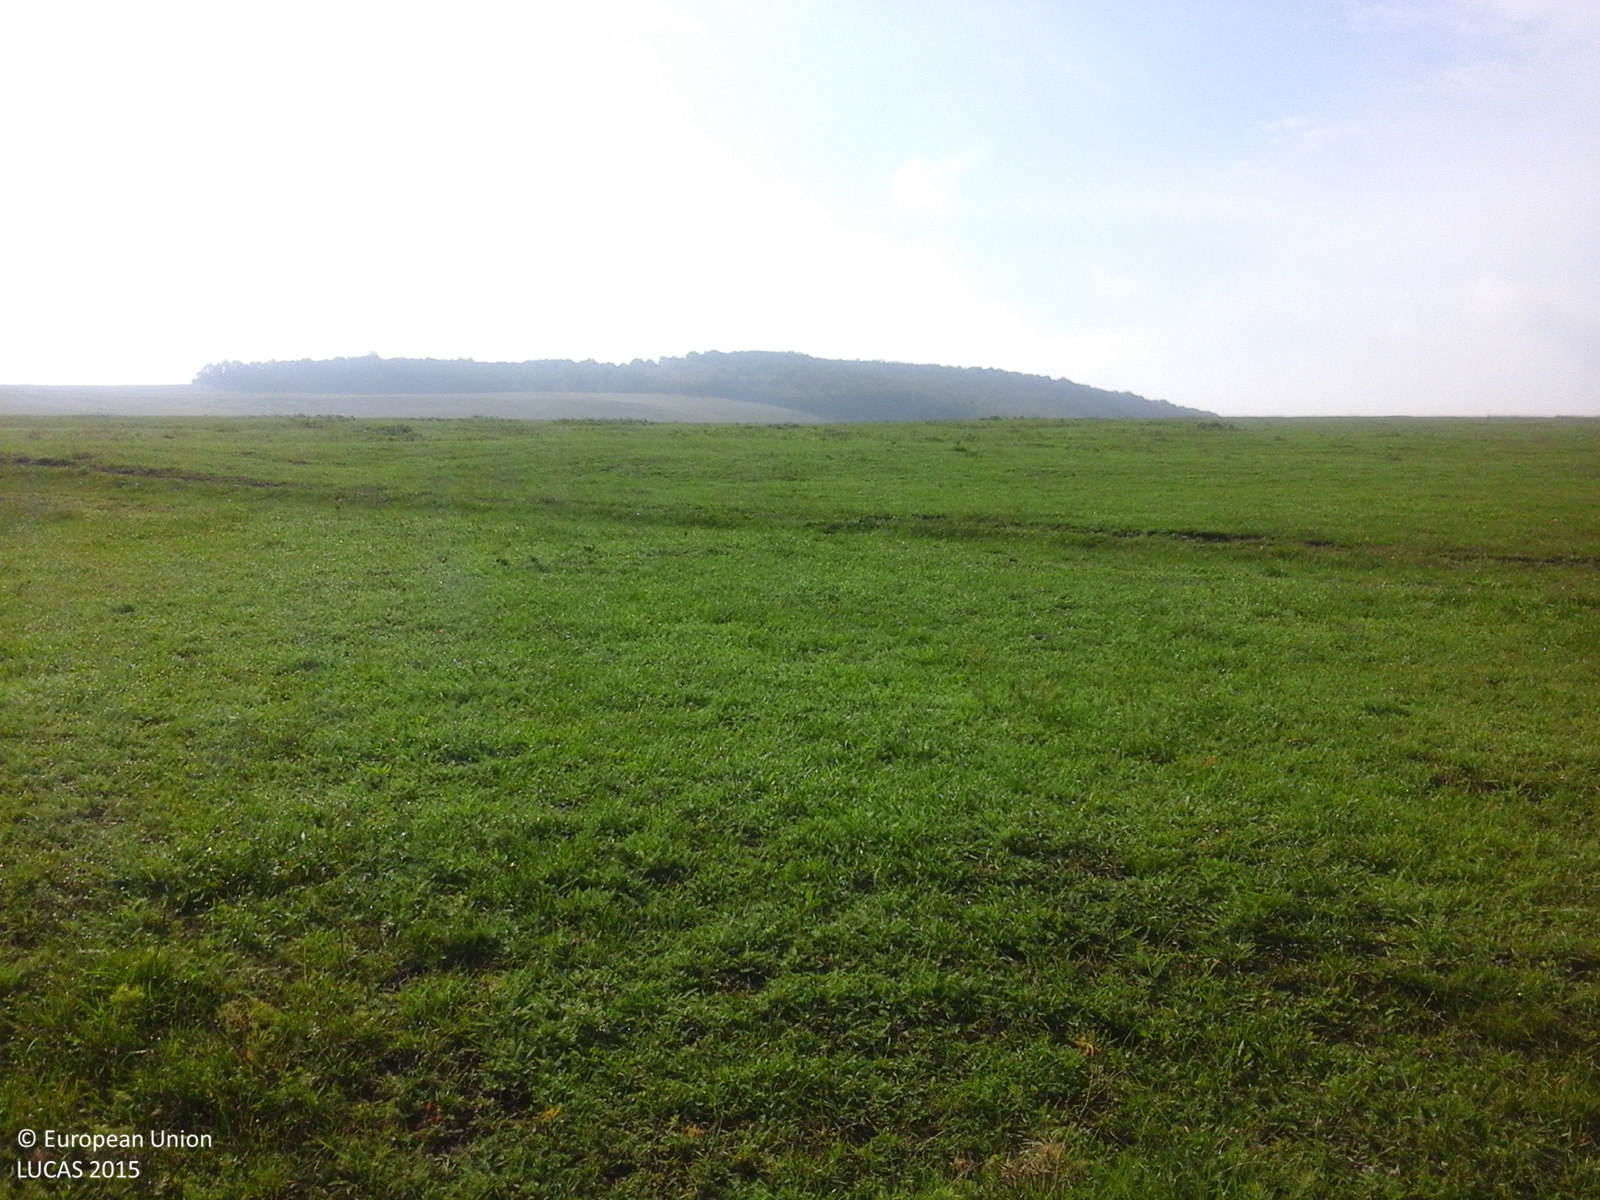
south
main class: Grassland
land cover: Grassland without tree/shrub cover
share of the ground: > 75 %
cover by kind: herbaceous plants 100 %
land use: Agriculture (excluding fallow land and kitchen gardens)
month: October
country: RO
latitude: 46.1501
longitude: 23.6237
